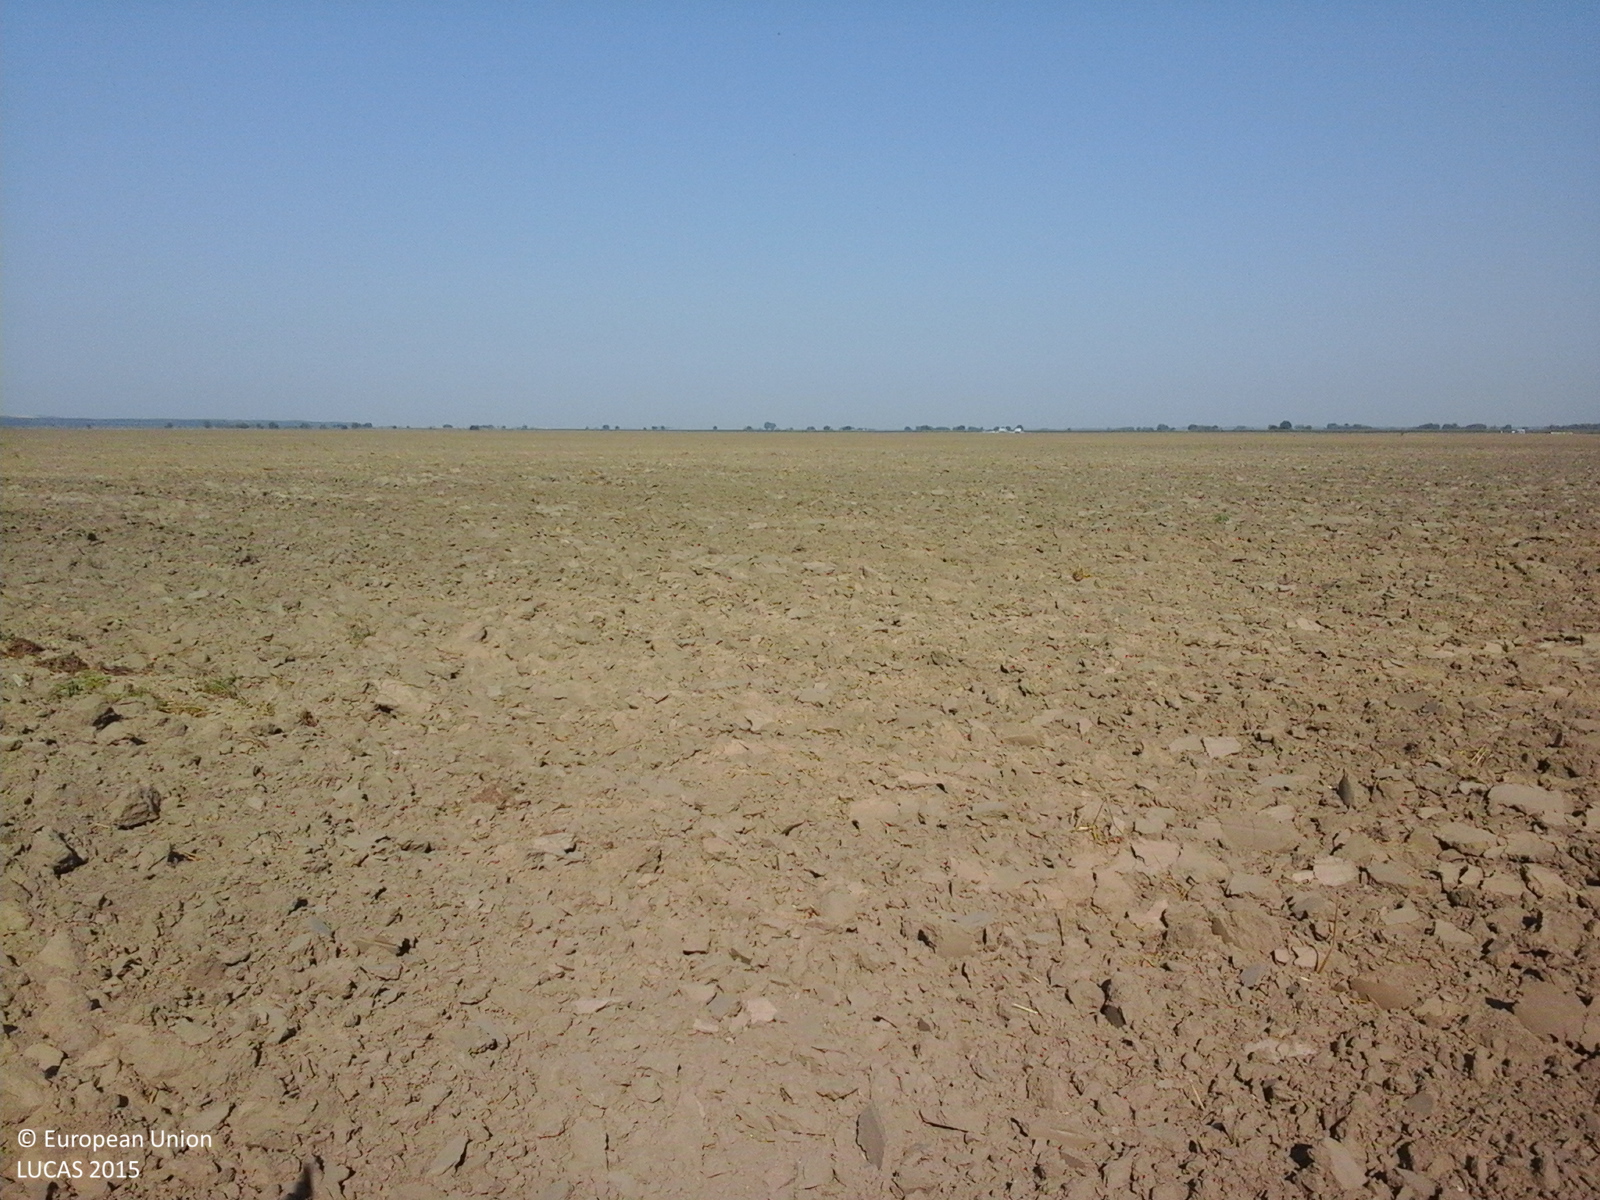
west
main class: Cropland
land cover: Common wheat
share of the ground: < 10 %
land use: Agriculture (excluding fallow land and kitchen gardens)
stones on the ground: < 10 %
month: July
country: RO
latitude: 44.2802
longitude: 27.9591
